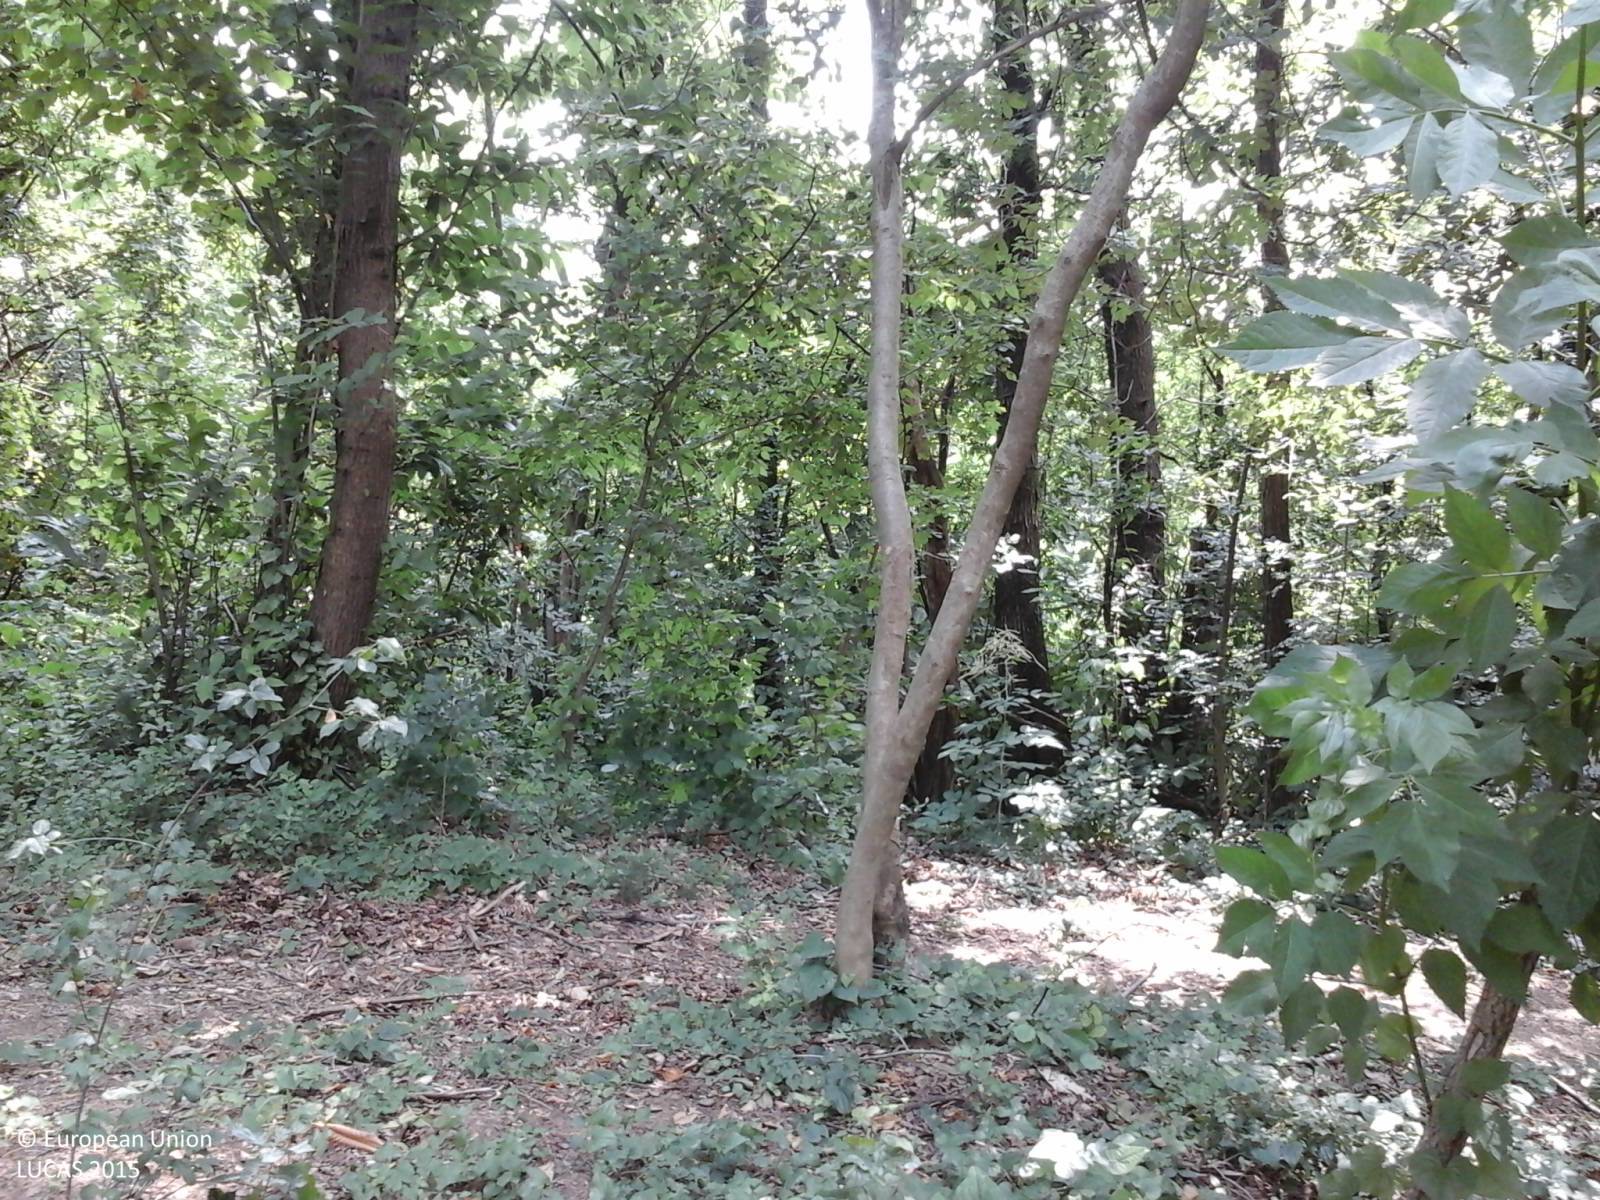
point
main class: Woodland
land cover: Broadleaved woodland
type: thermophilous deciduous forest
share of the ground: > 75 %
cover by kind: broadleaved forest trees 90 %, shrubs 10 %
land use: Forestry
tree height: > 5 m
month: June
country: IT
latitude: 46.1968
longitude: 13.1455
